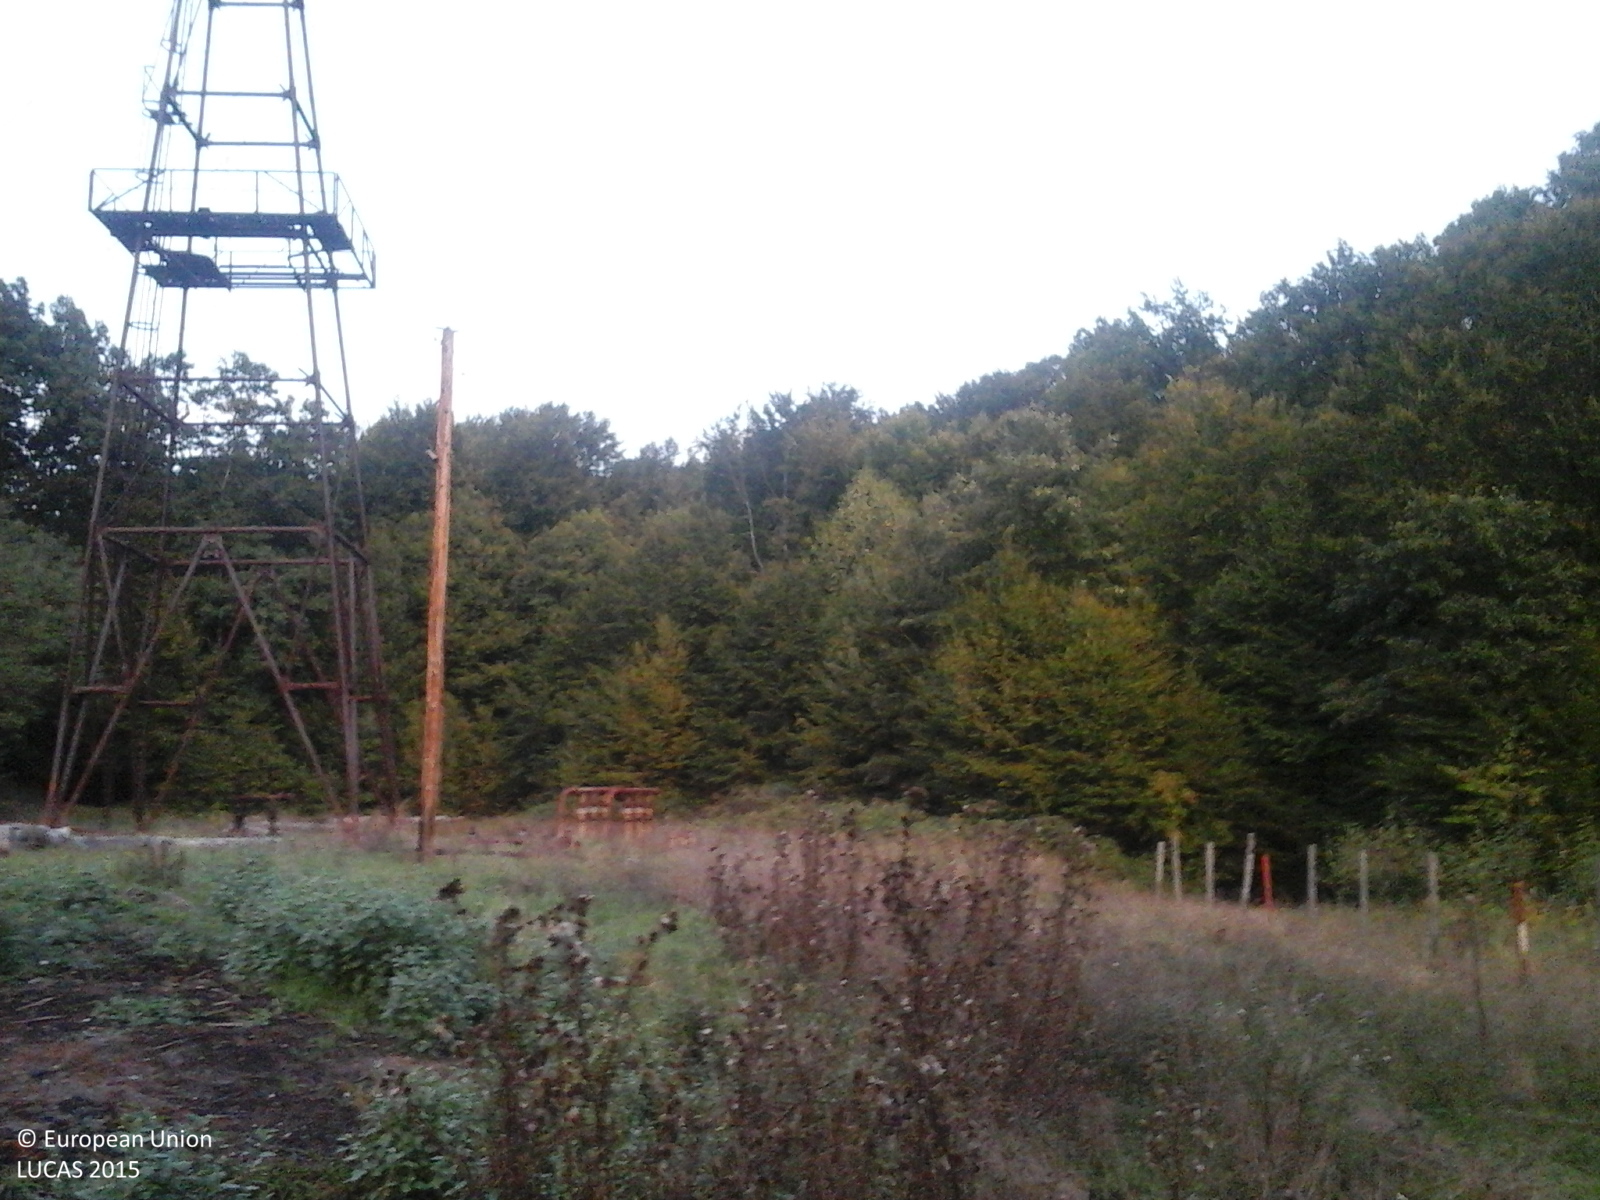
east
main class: Grassland
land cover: Grassland with sparse tree/shrub cover
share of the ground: > 75 %
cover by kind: herbaceous plants 85 %, shrubs 10 %, broadleaved forest trees 5 %
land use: Fallow land
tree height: > 5 m
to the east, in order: Grassland with sparse tree/shrub cover; Shrubland without tree cover; Broadleaved woodland; Ditches and canals; Broadleaved woodland
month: September
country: RO
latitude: 44.9137
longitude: 23.4446
